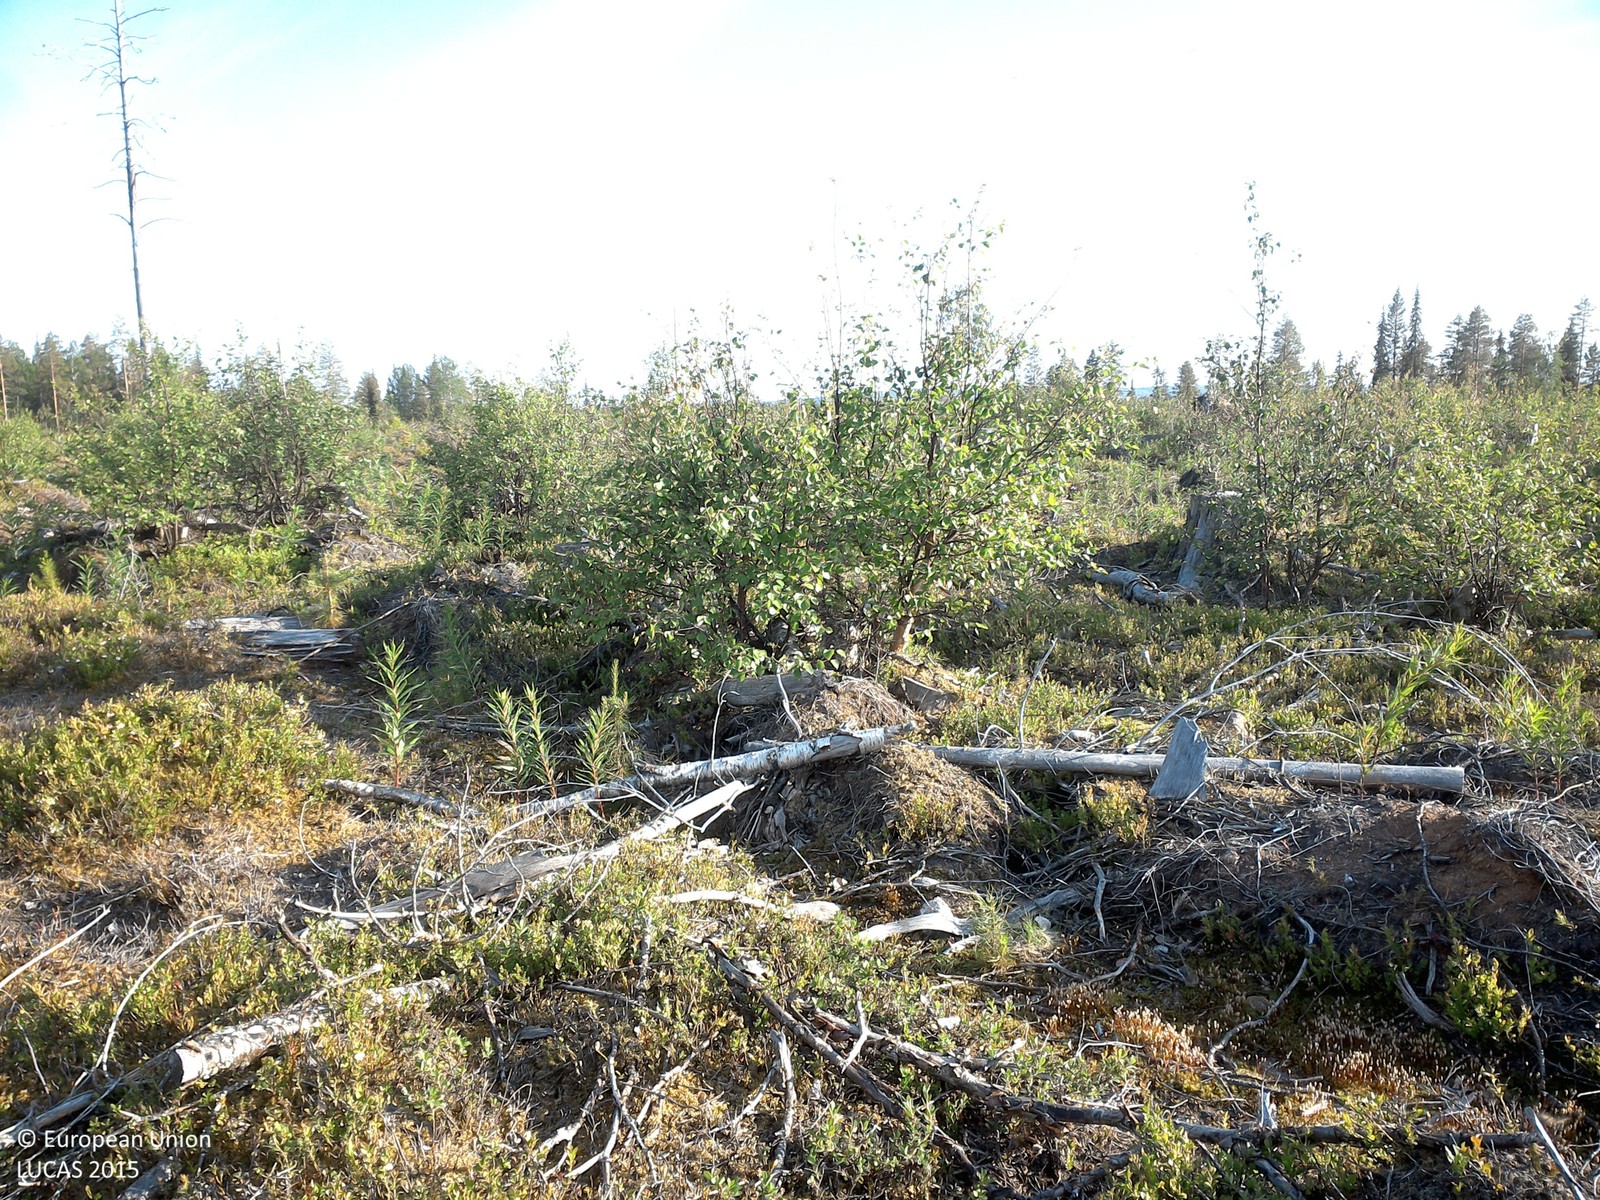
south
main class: Woodland
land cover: Broadleaved woodland
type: boreal forest
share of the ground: 10 - 25 %
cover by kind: shrubs 70 %, broadleaved forest trees 15 %, unconsolidated bare surface 10 %, lichens and mosses 5 %
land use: Forestry
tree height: < 5 m
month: July
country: SE
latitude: 67.1293
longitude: 22.8092
